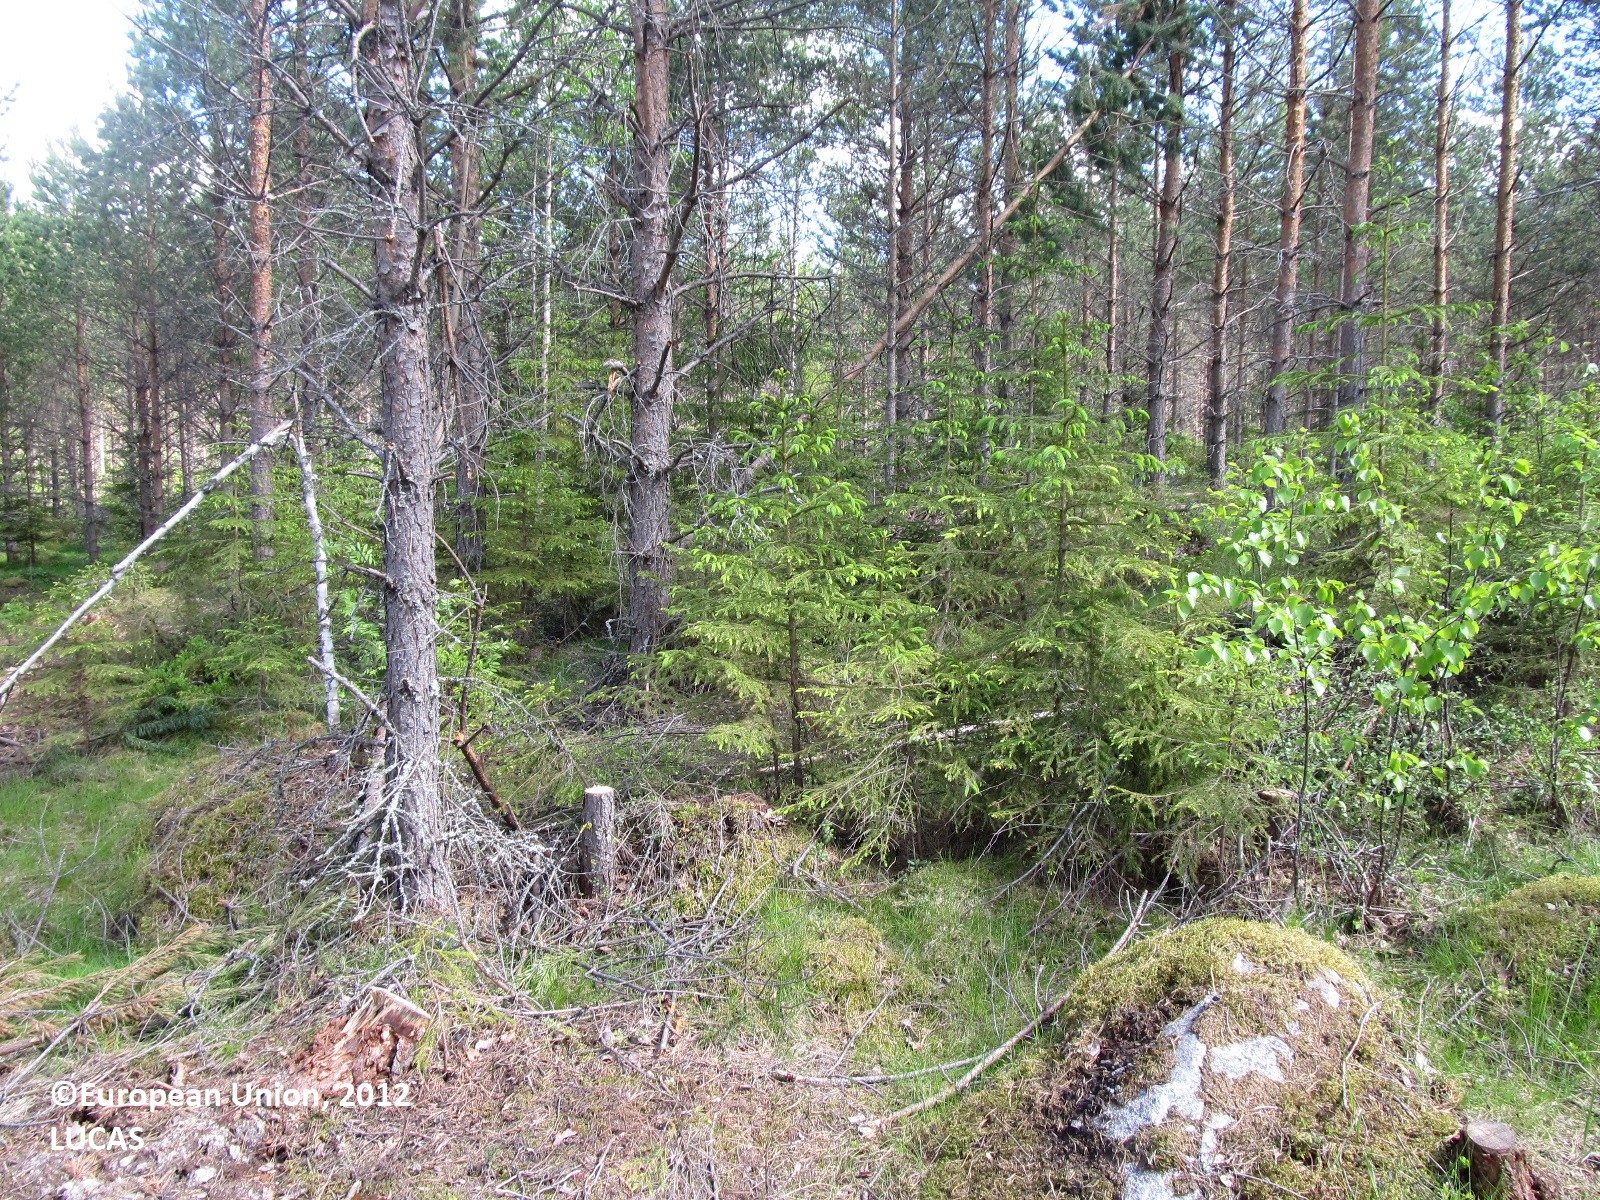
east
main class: Woodland
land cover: Pine dominated coniferous woodland
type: boreal forest
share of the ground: 25 - 50 %
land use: Forestry
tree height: > 5 m
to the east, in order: Pine dominated coniferous woodland; Other bare soil; Pine dominated coniferous woodland; Other bare soil; Pine dominated coniferous woodland; Other bare soil; Pine dominated coniferous woodland; Grassland with sparse tree/shrub cover; Pine dominated mixed woodland
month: June
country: FI
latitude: 62.7193
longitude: 27.5520
